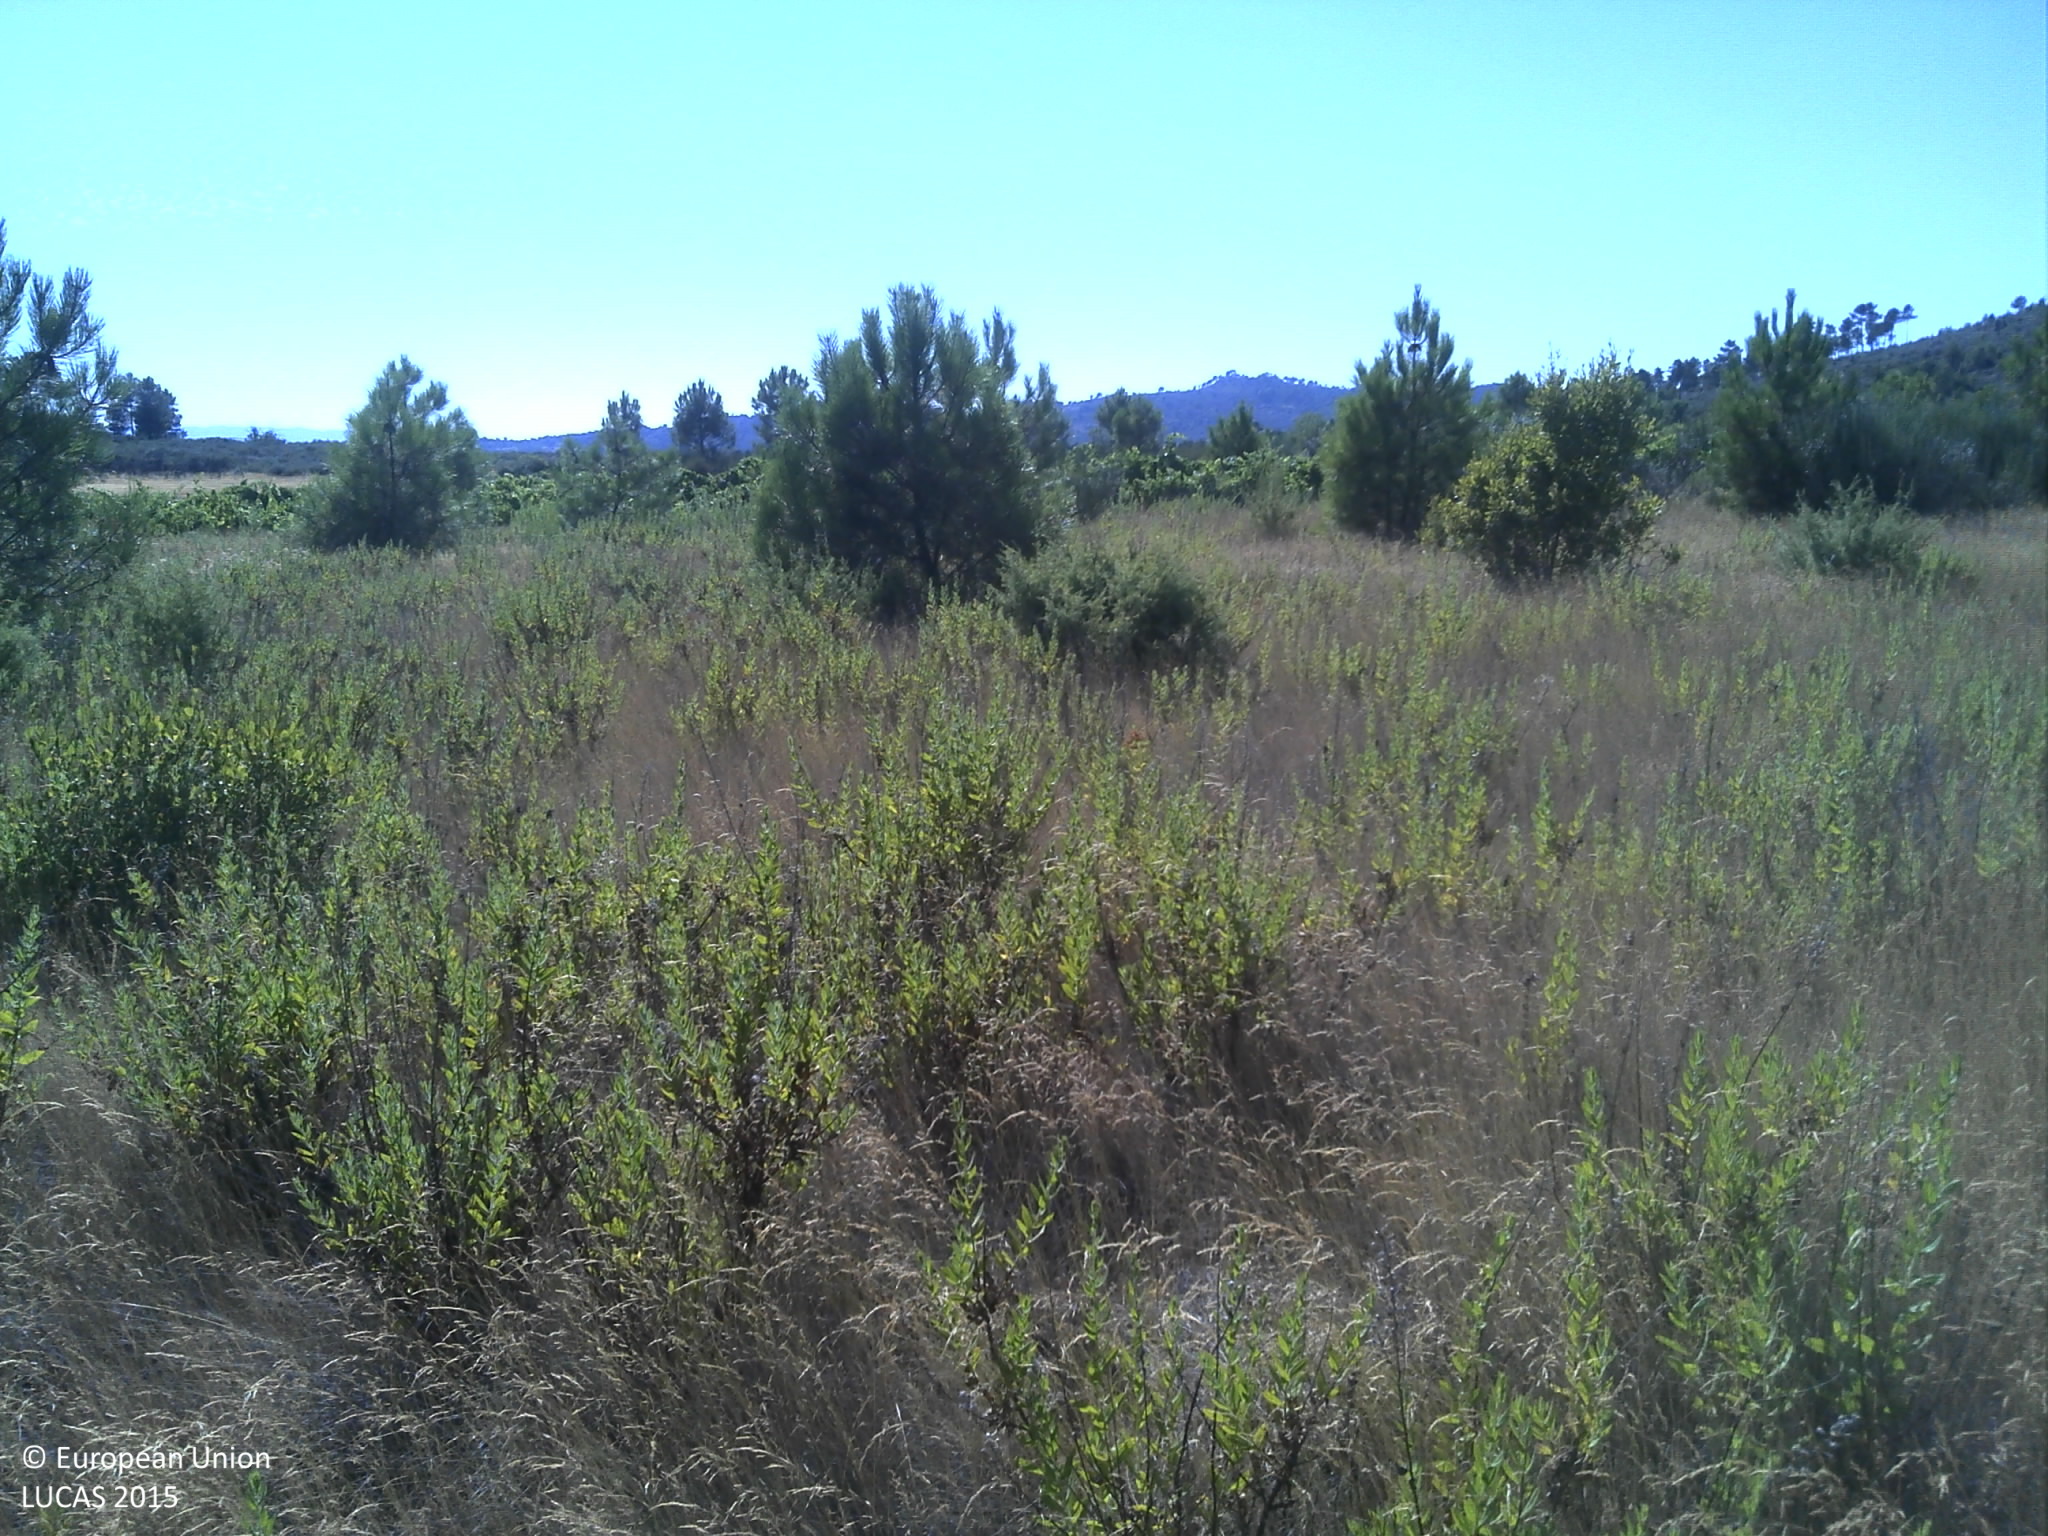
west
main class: Grassland
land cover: Grassland with sparse tree/shrub cover
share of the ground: > 75 %
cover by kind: herbaceous plants 85 %, coniferous forest trees 5 %, shrubs 5 %, unconsolidated bare surface 5 %
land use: Agriculture (excluding fallow land and kitchen gardens)
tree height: < 5 m
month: July
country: PT
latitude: 41.1758
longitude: -7.2694
